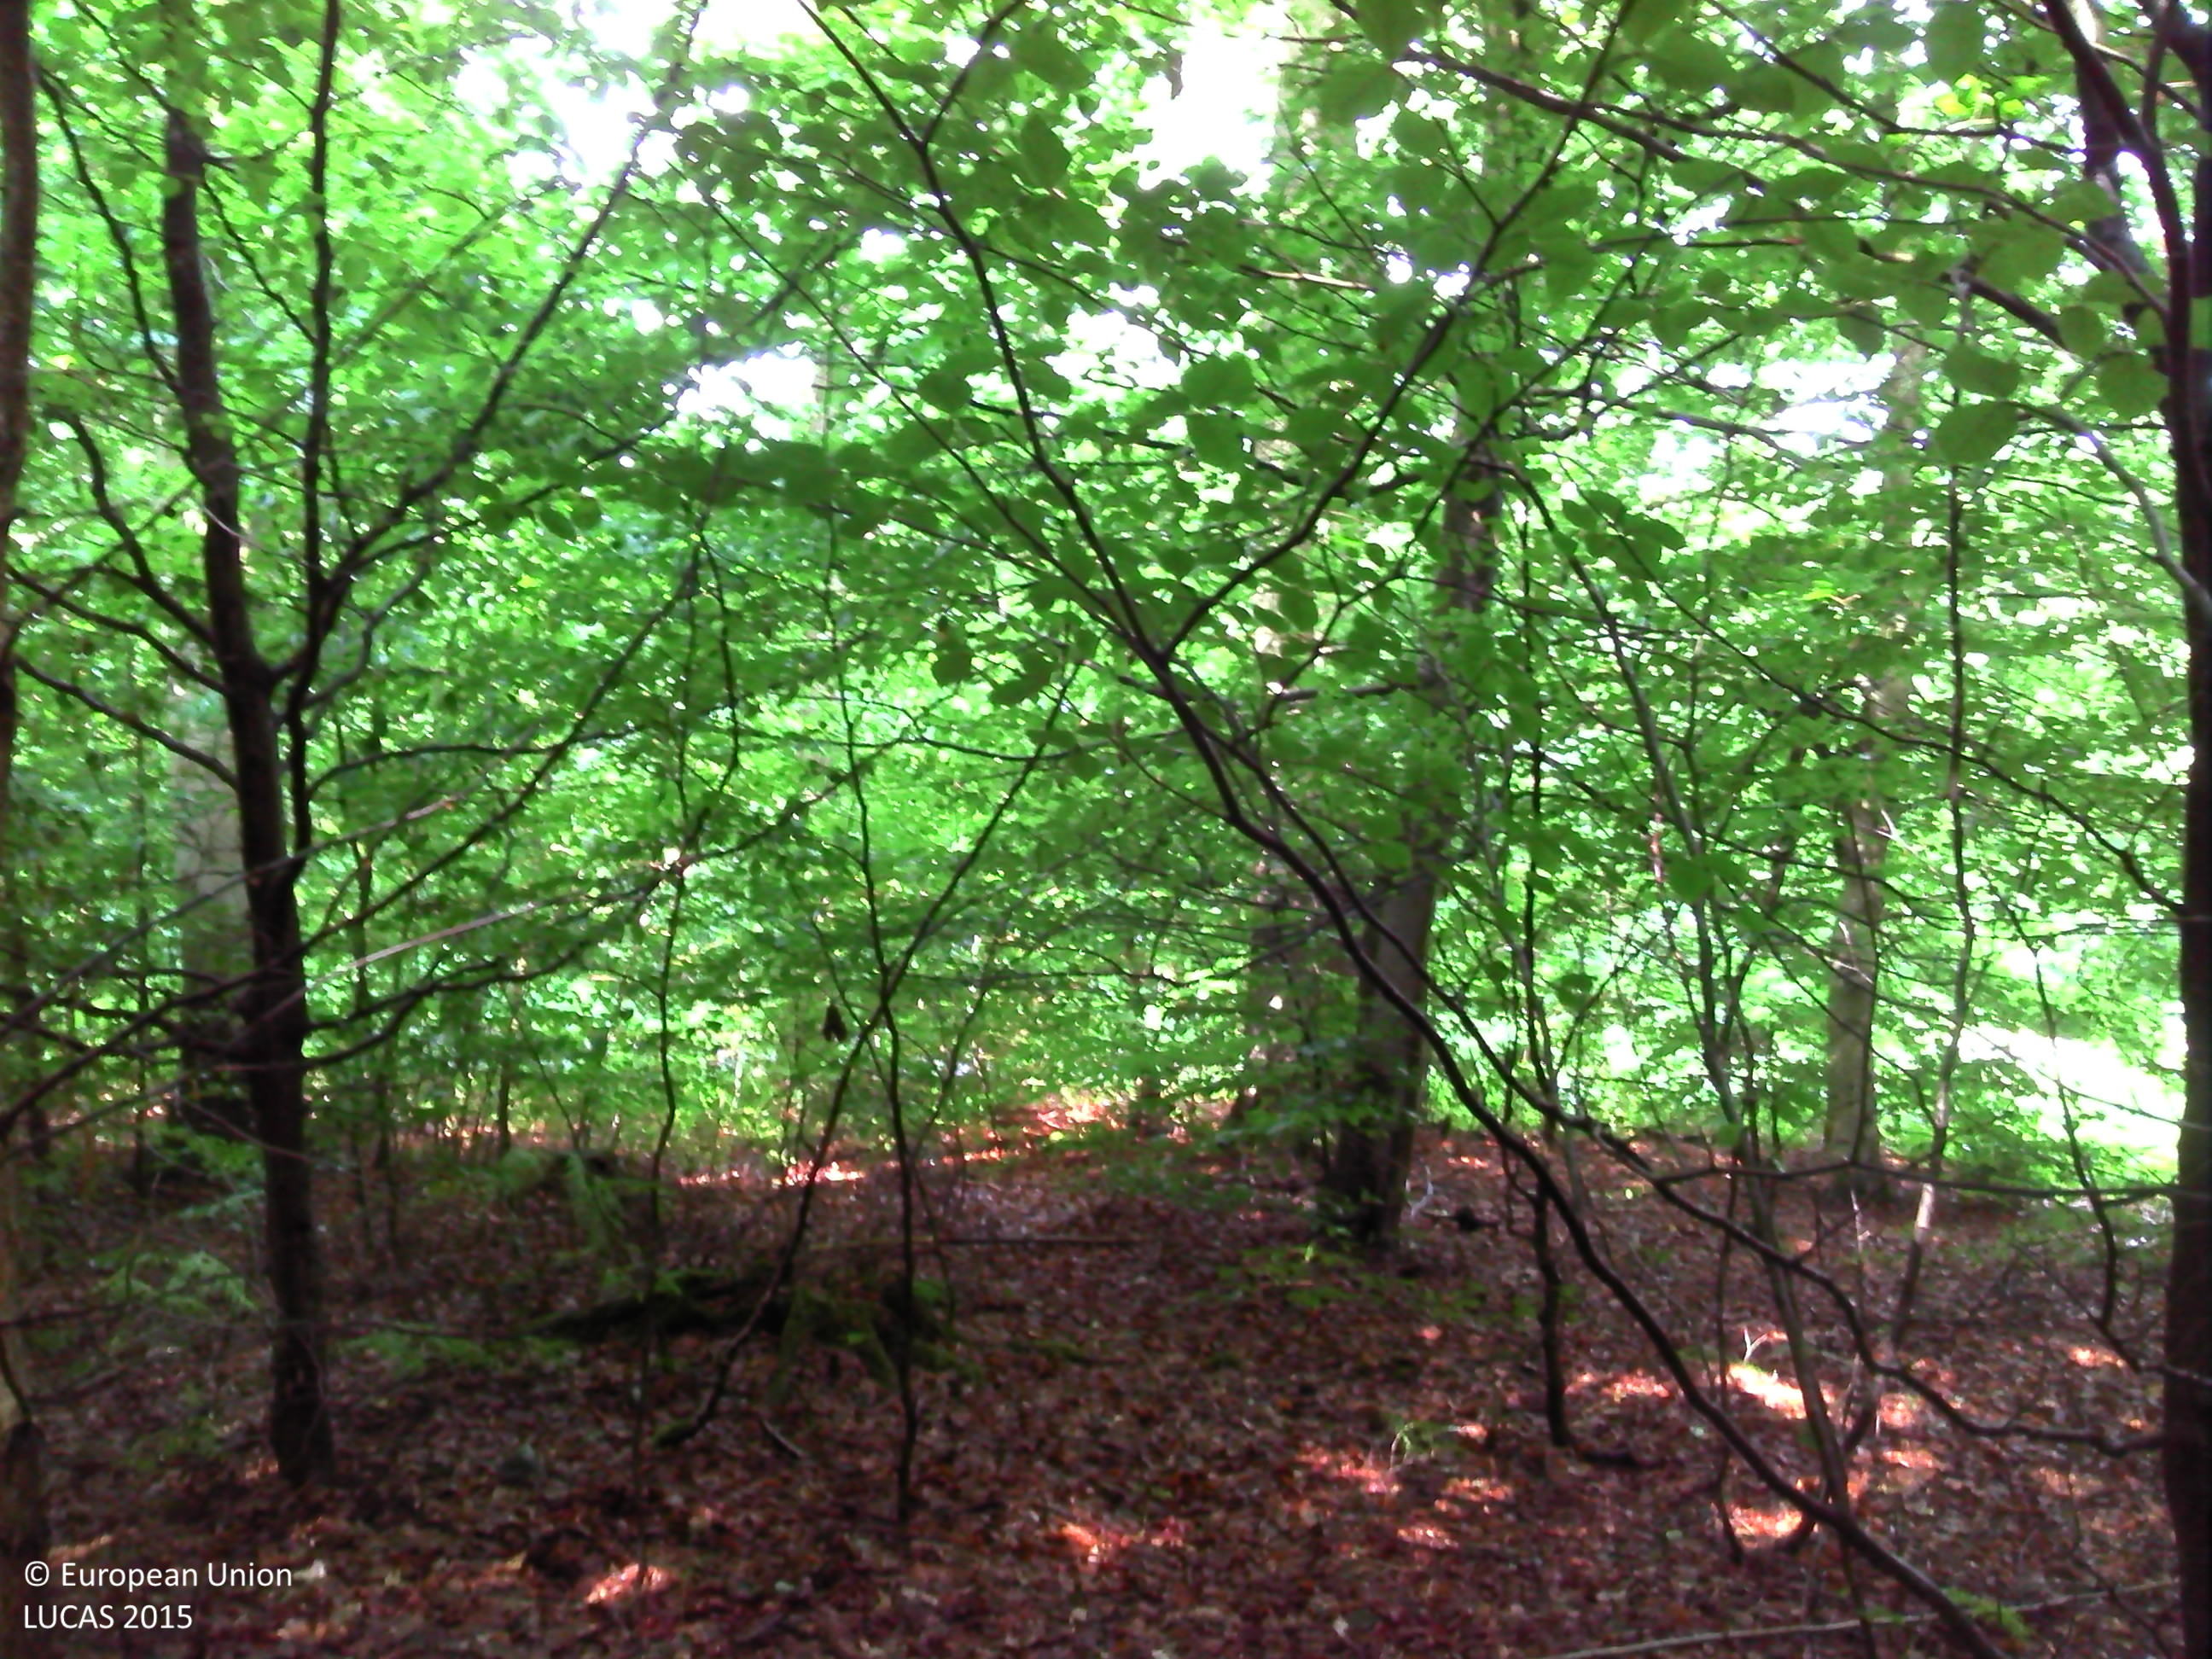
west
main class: Woodland
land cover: Broadleaved woodland
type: beech forest
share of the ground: > 75 %
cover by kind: broadleaved forest trees 90 %, herbaceous plants 5 %, lichens and mosses 5 %
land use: Forestry
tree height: > 5 m
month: July
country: BE
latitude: 50.4696
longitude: 5.8707
